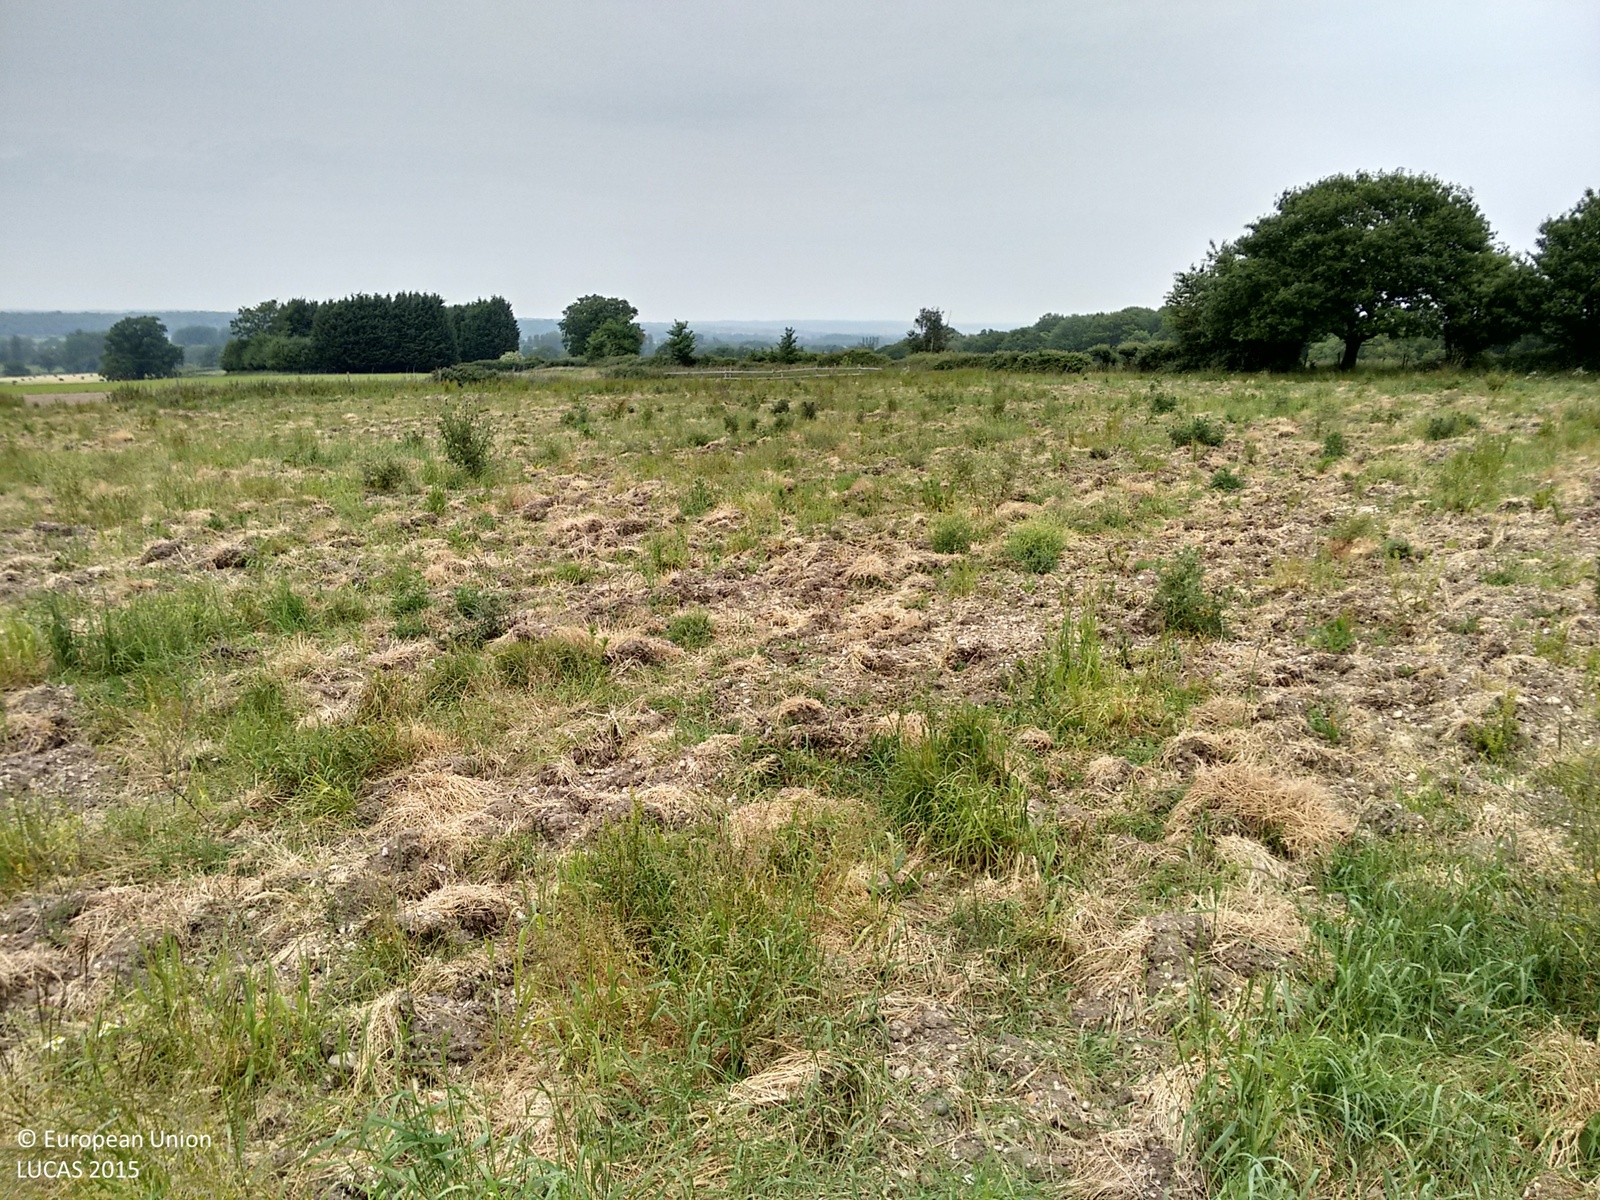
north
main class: Grassland
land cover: Grassland without tree/shrub cover
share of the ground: > 75 %
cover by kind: herbaceous plants 75 %, unconsolidated bare surface 25 %
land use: Agriculture (excluding fallow land and kitchen gardens)
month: June
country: GB
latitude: 51.4013
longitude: -1.0997
